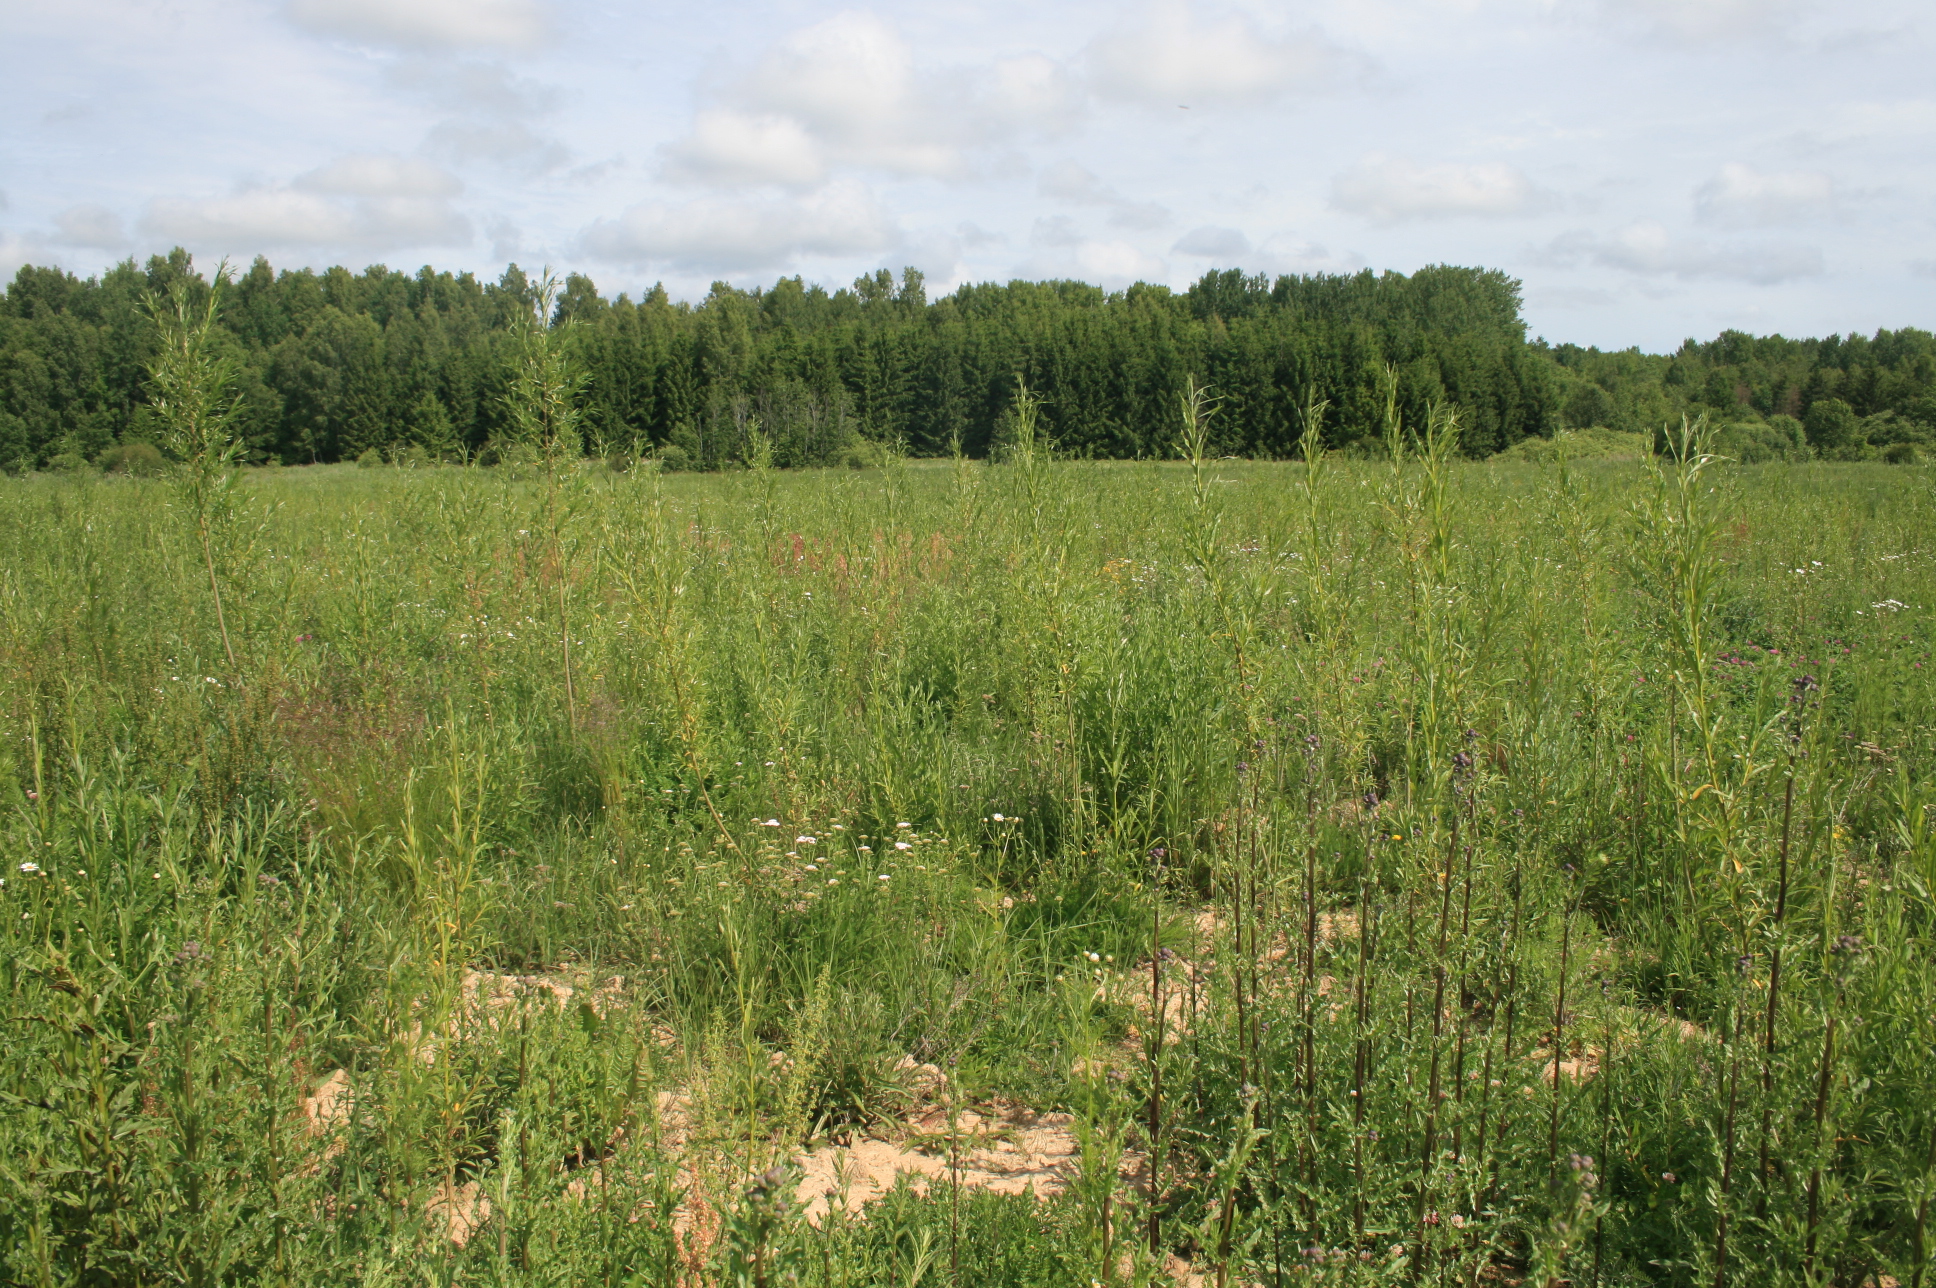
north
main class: Shrubland
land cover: Shrubland without tree cover
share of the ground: 50 - 75 %
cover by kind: shrubs 60 %, herbaceous plants 40 %
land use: Abandoned areas
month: June
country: LT
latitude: 55.2496
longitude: 22.0894
